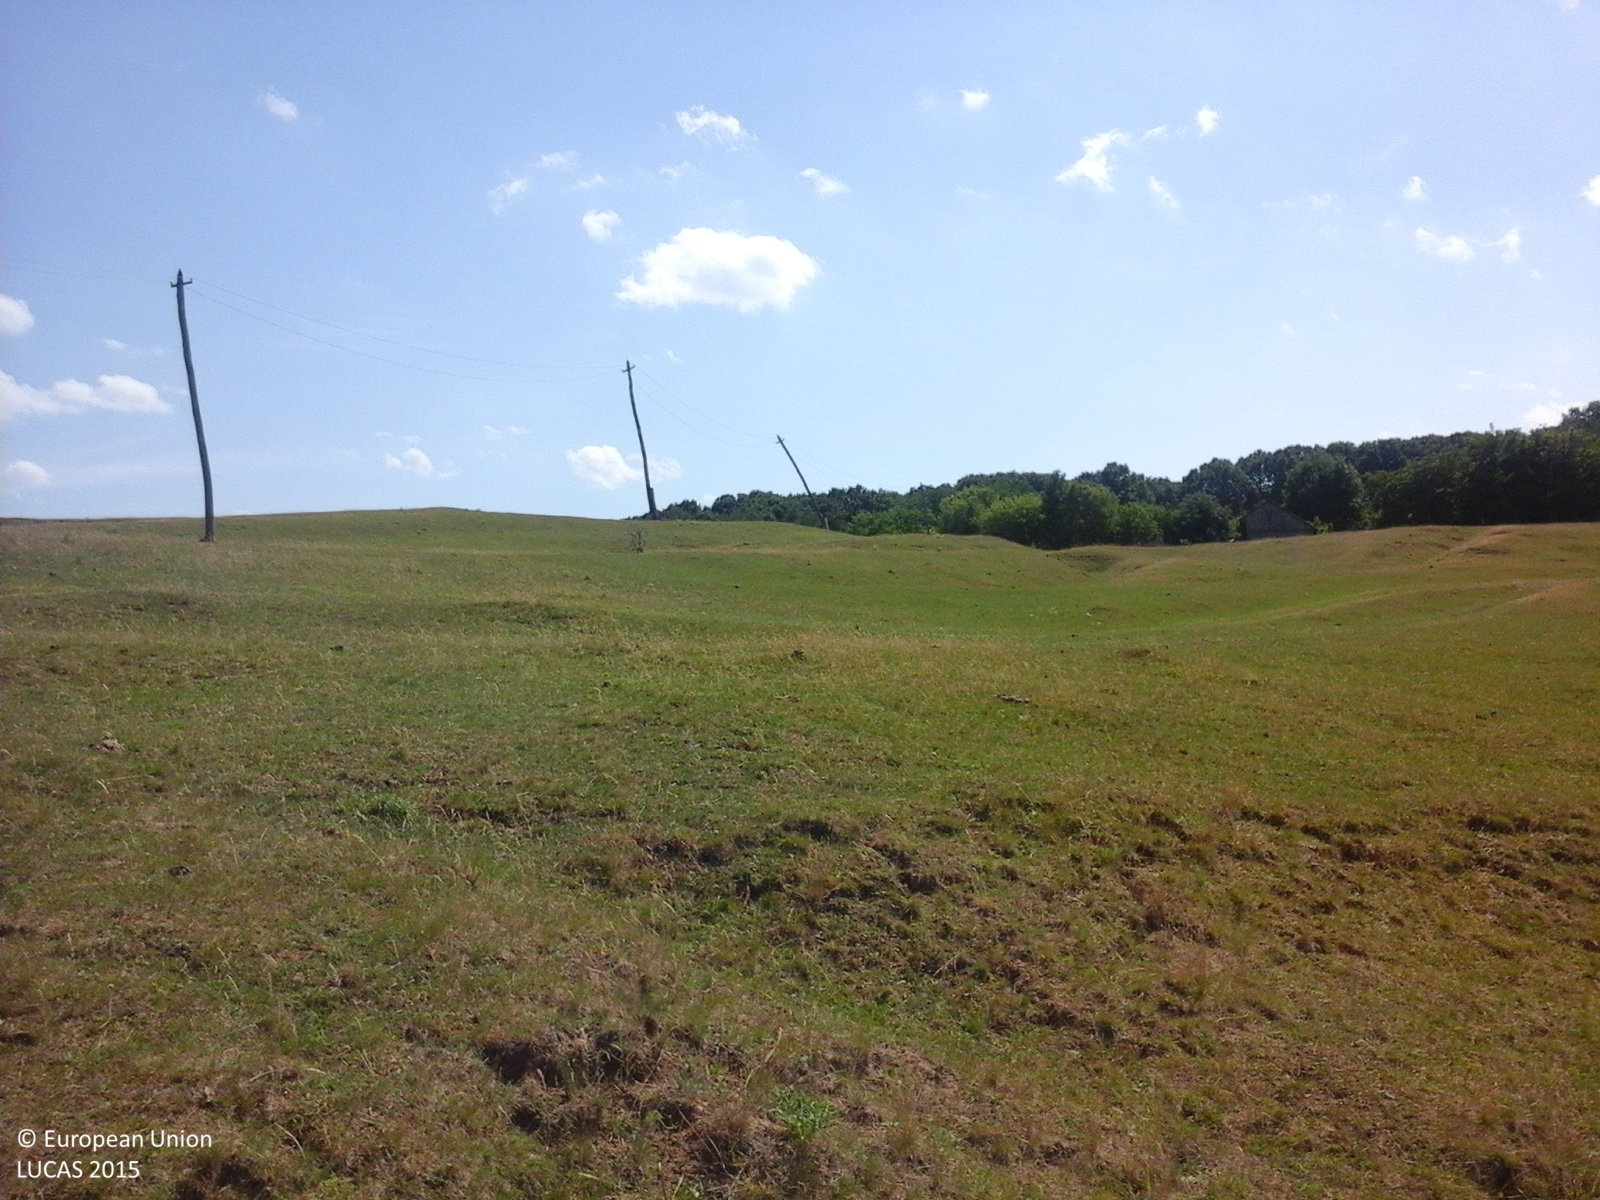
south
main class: Grassland
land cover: Grassland without tree/shrub cover
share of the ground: > 75 %
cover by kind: herbaceous plants 100 %
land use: Agriculture (excluding fallow land and kitchen gardens)
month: June
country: RO
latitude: 47.7955
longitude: 26.4980
